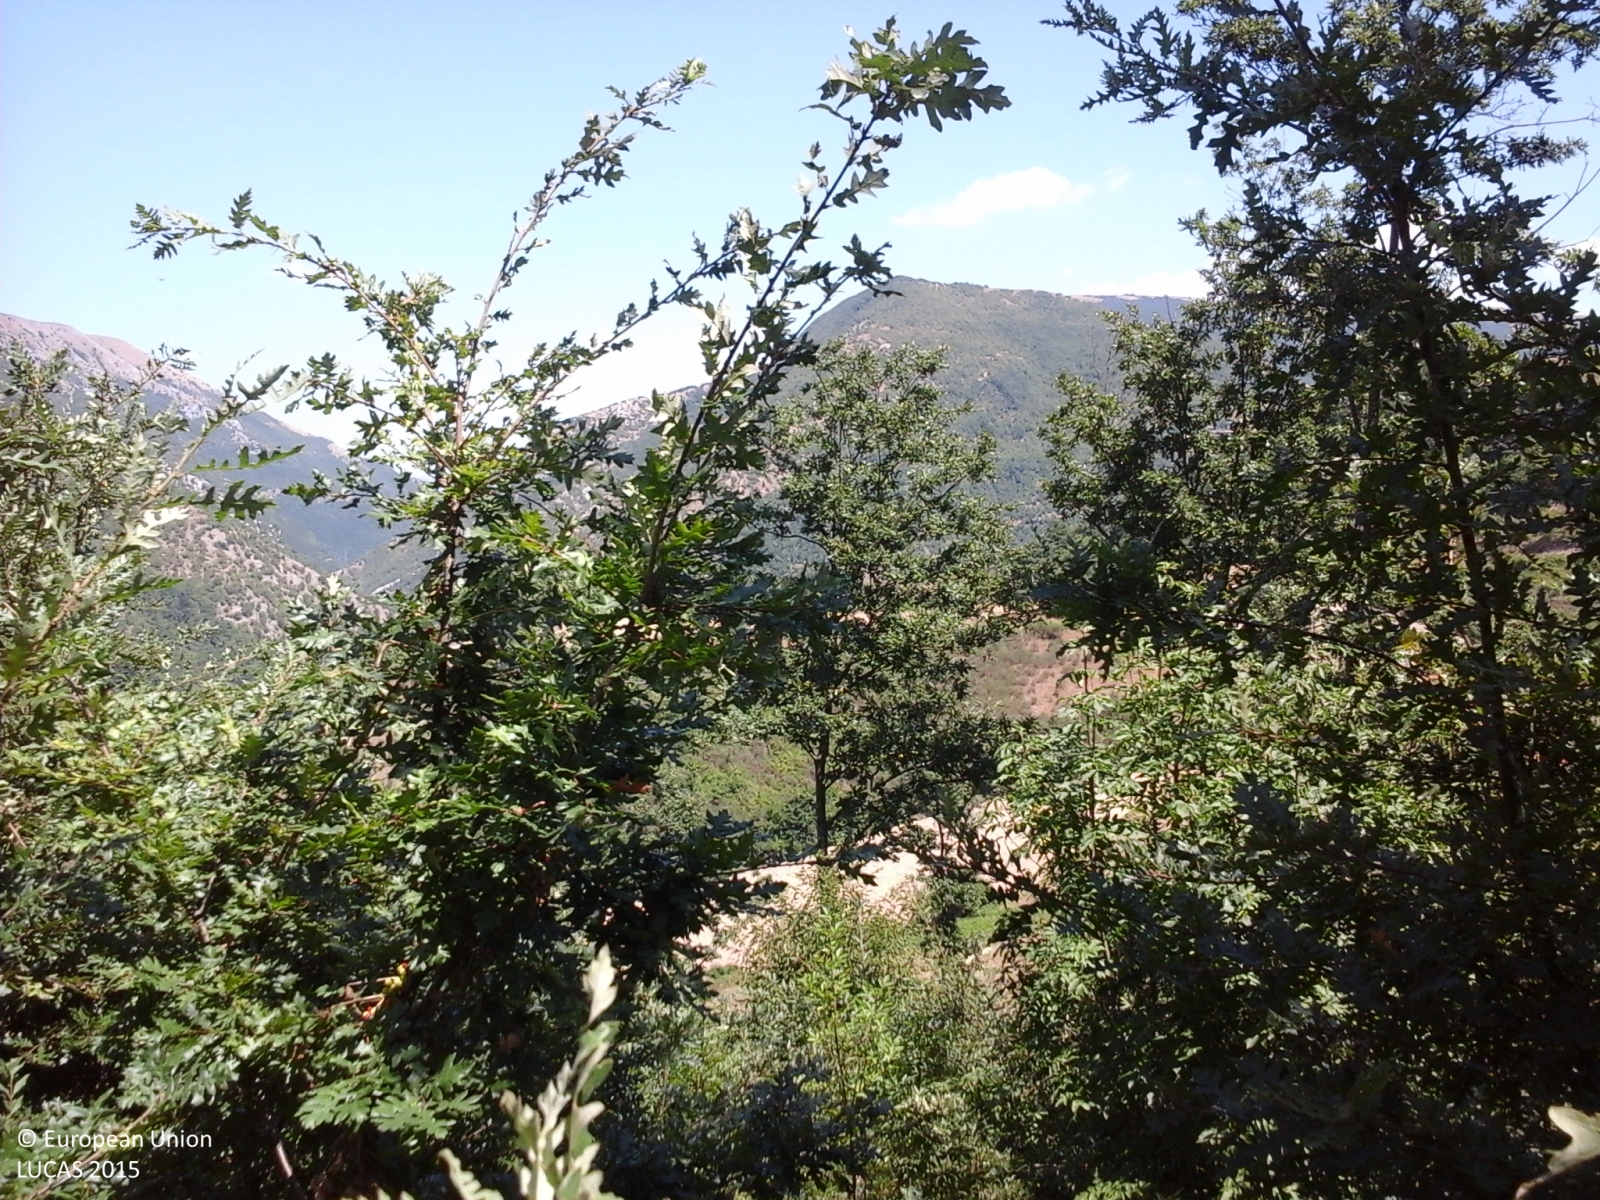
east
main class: Woodland
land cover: Broadleaved woodland
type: thermophilous deciduous forest
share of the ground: > 75 %
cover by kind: broadleaved forest trees 100 %
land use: Forestry
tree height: > 5 m
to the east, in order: Broadleaved woodland; Grass margins; Common wheat; Grassland without tree/shrub cover; Common wheat; Abandoned hedges; Common wheat
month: August
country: IT
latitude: 43.5069
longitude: 12.5537
